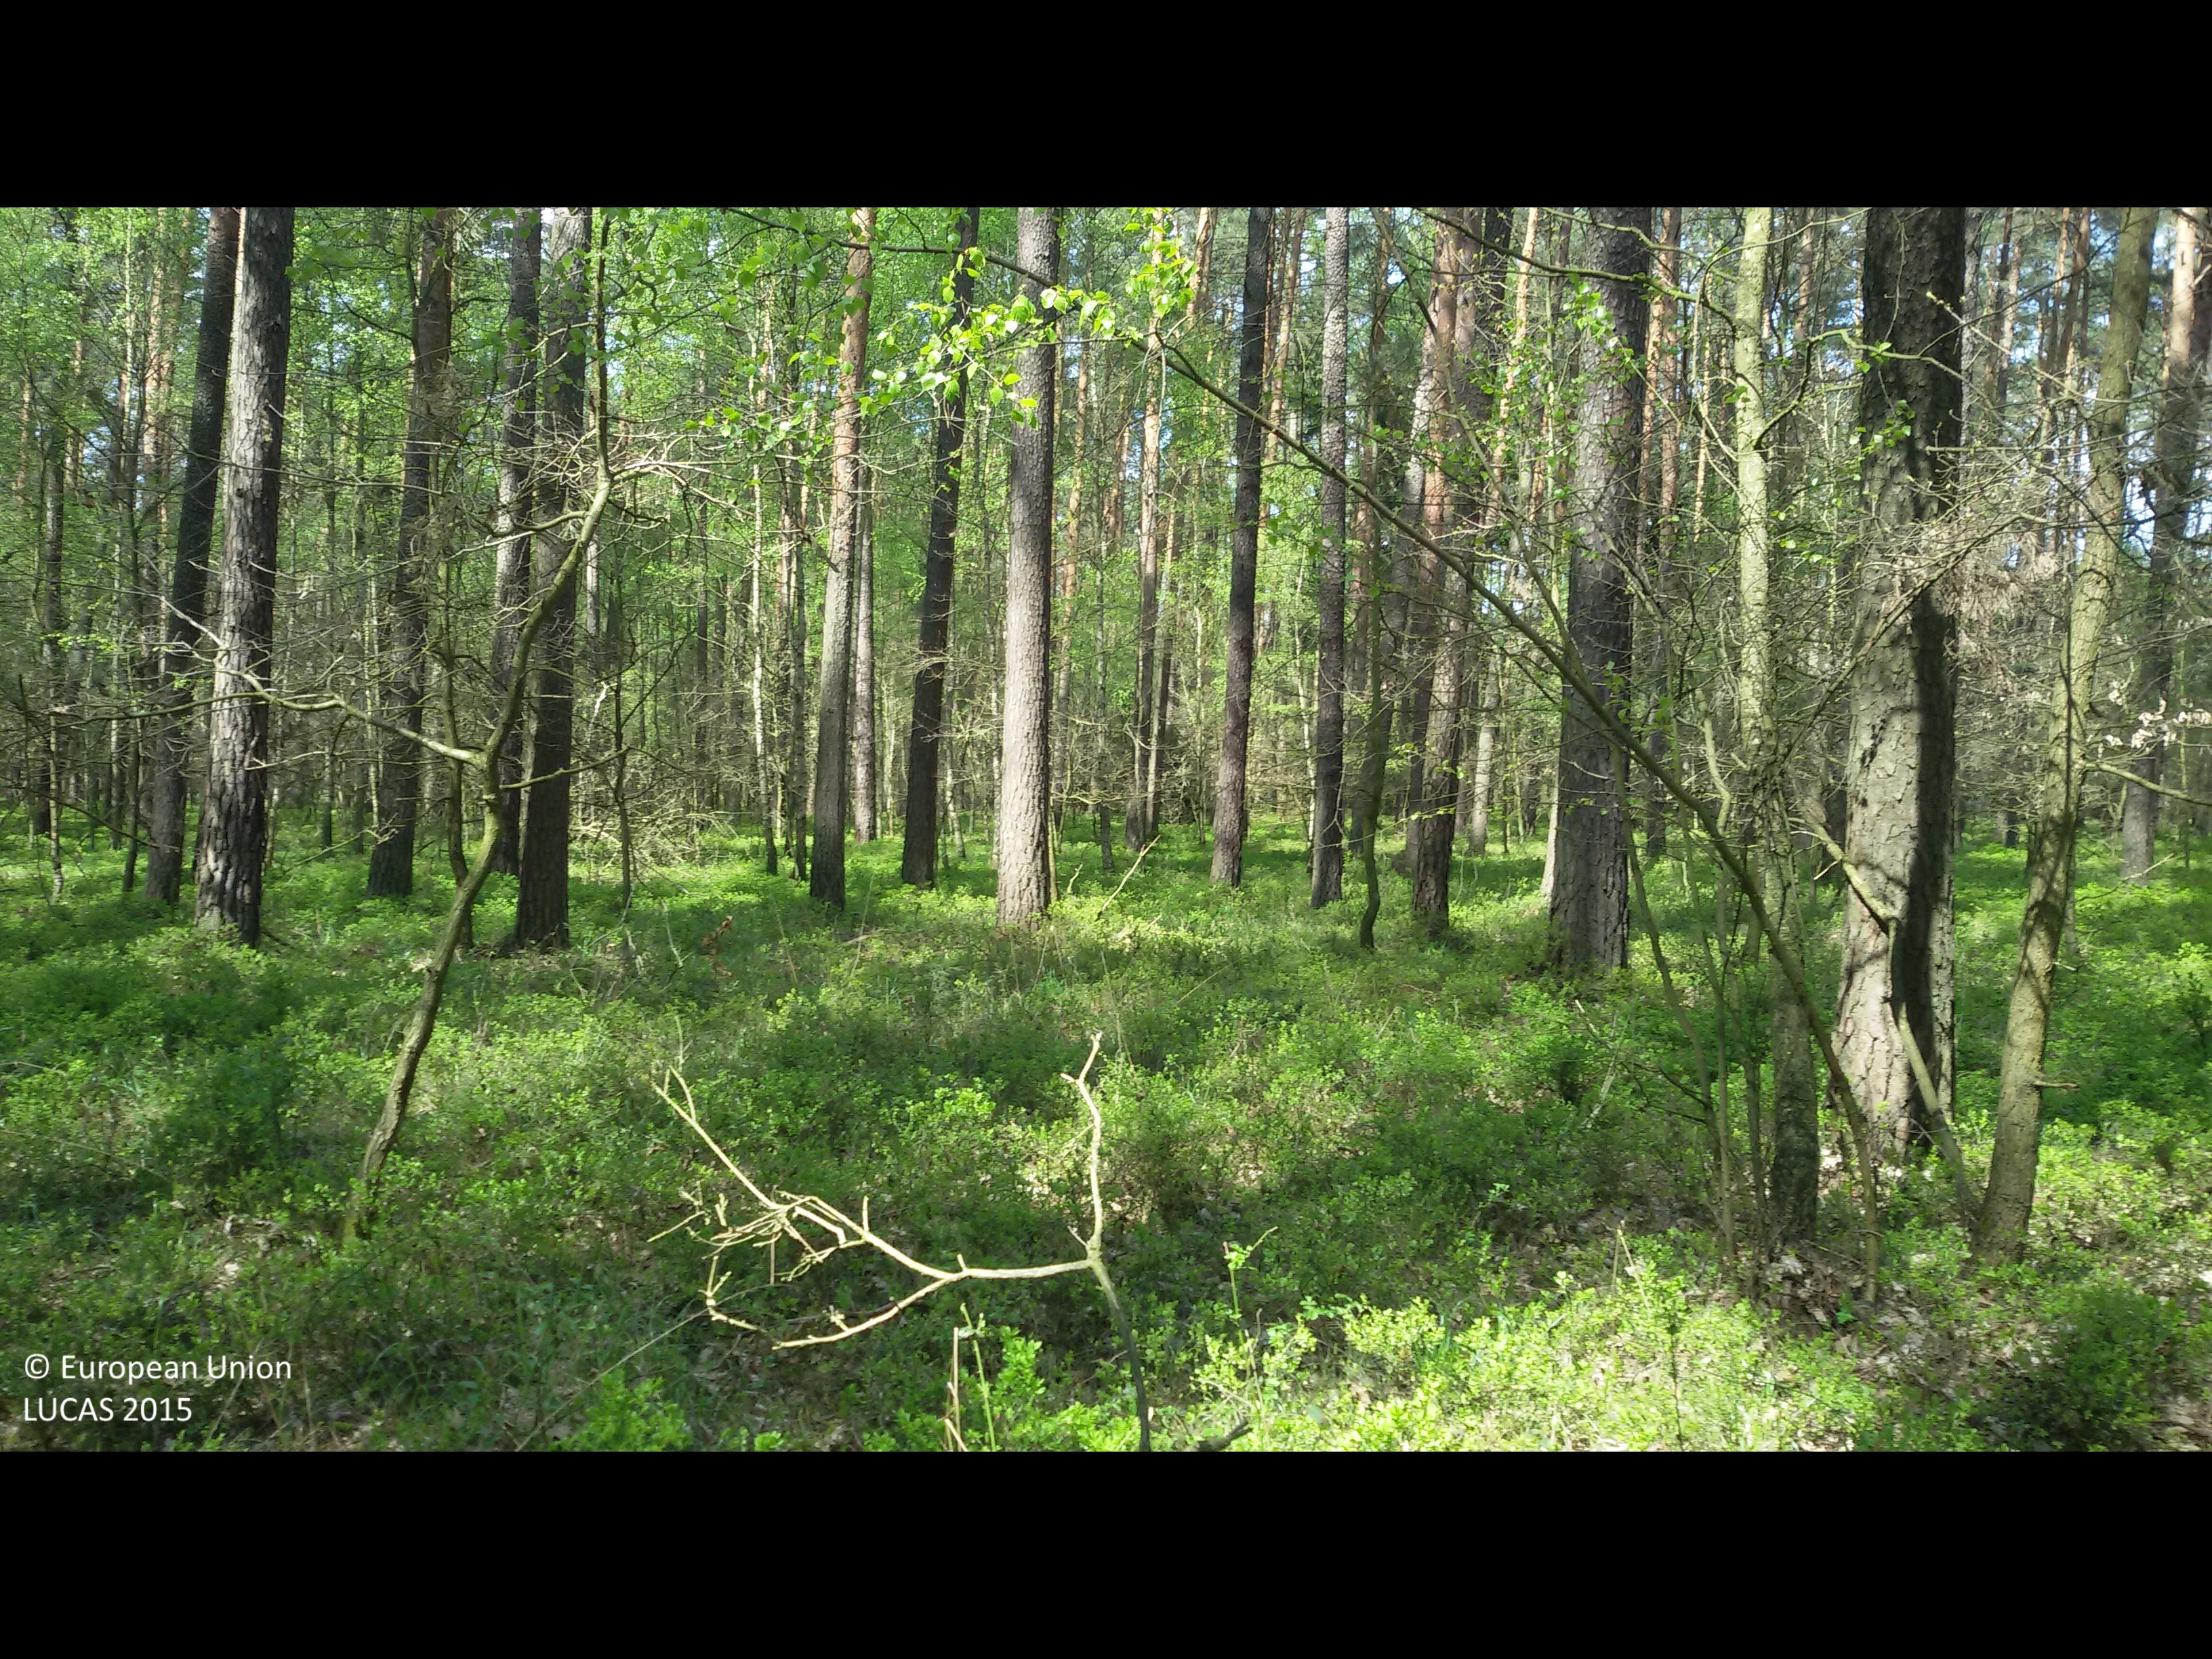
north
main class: Woodland
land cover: Pine dominated mixed woodland
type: hemiboreal forest and nemoral coniferous forest and mixed broadleaved-coniferous forest
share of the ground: > 75 %
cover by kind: coniferous forest trees 60 %, broadleaved forest trees 25 %, herbaceous plants 10 %, shrubs 5 %
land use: Forestry
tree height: > 5 m
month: May
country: PL
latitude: 52.9099
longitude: 17.0132
